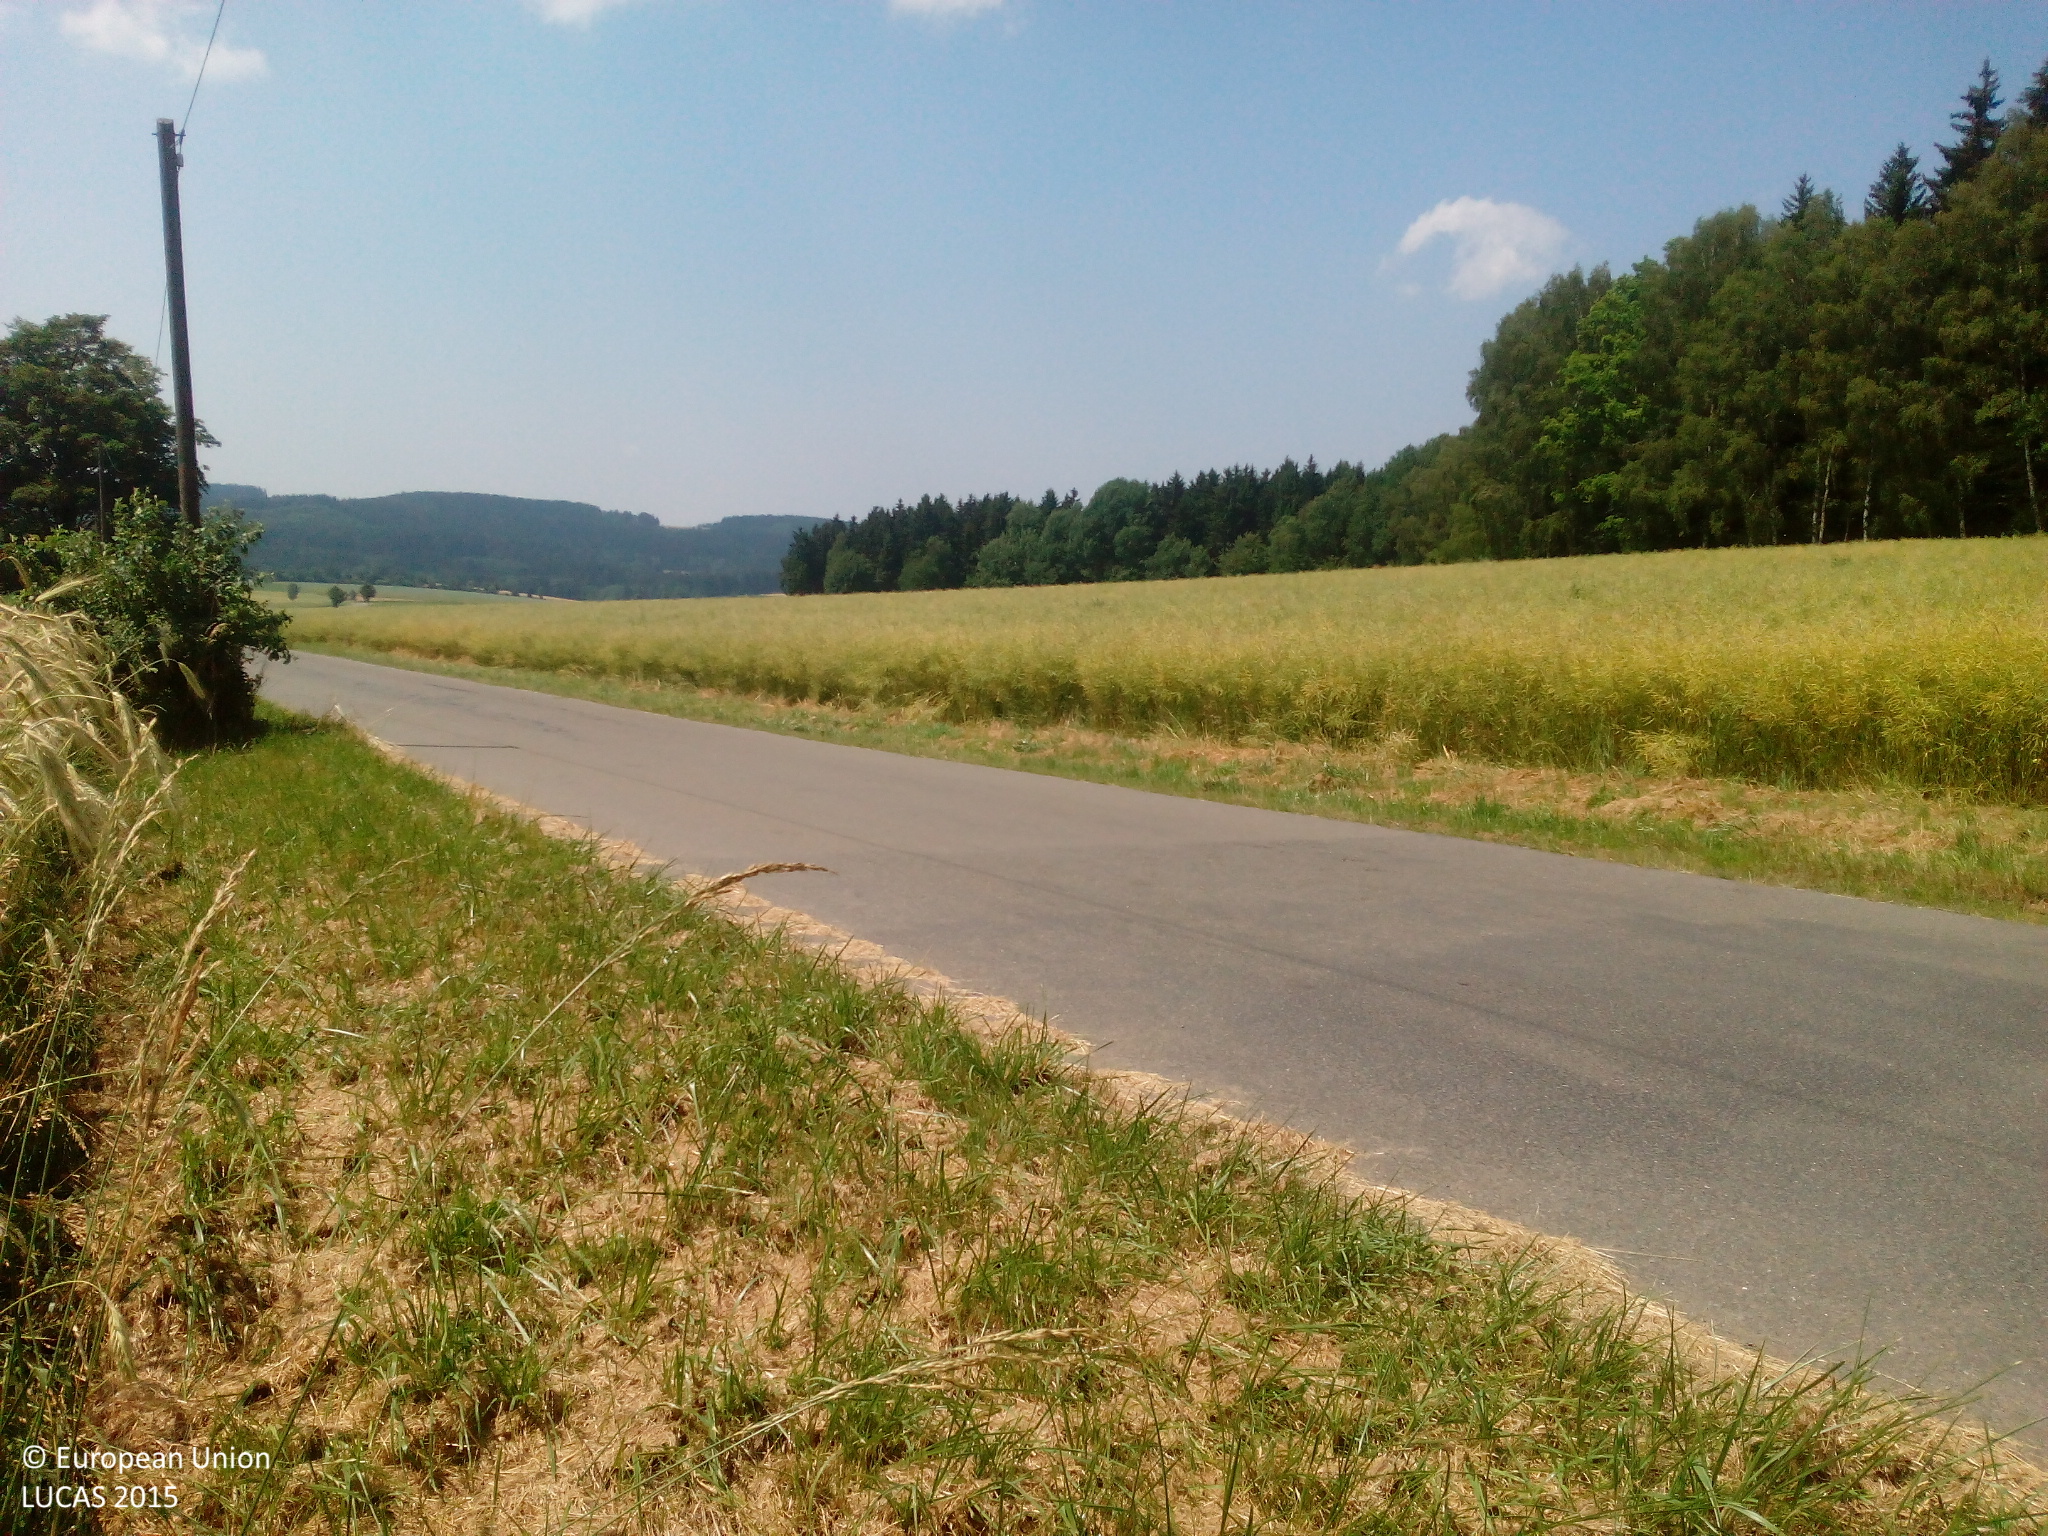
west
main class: Cropland
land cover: Rye
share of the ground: > 75 %
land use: Agriculture (excluding fallow land and kitchen gardens)
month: July
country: DE
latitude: 49.5643
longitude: 12.4468
